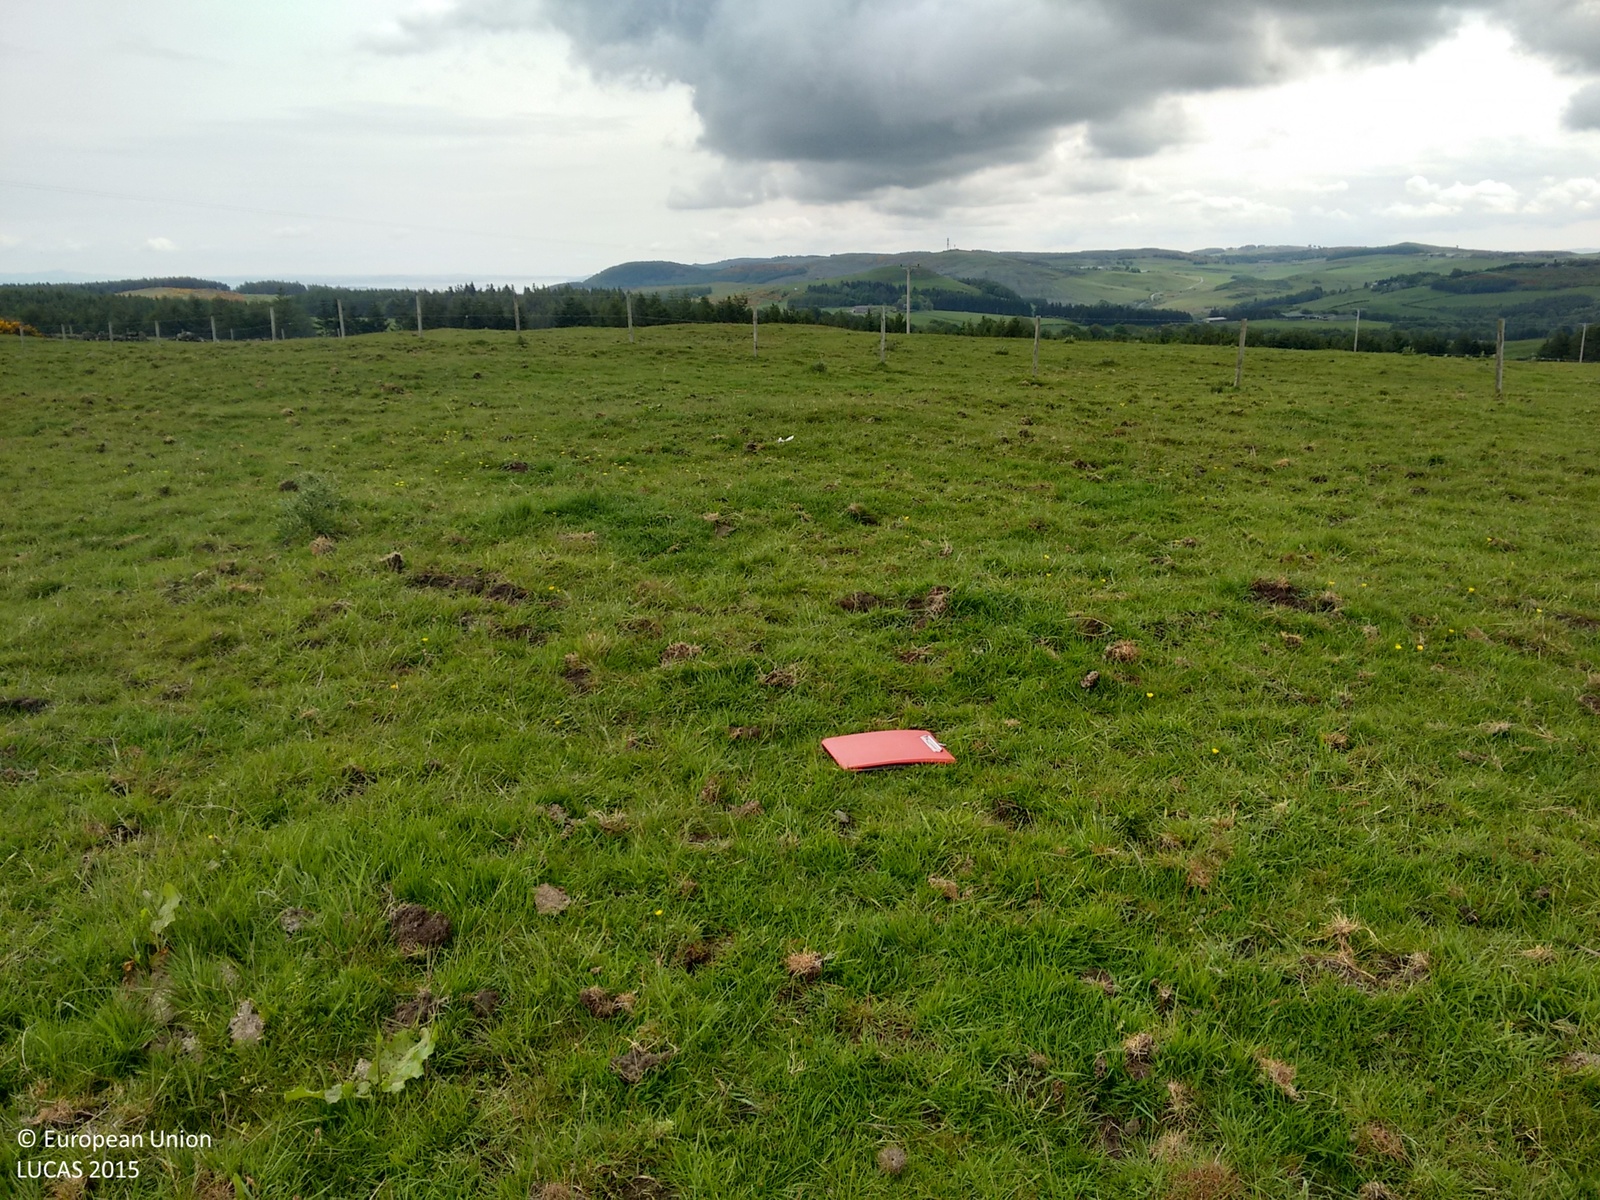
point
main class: Grassland
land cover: Grassland without tree/shrub cover
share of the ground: > 75 %
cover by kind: herbaceous plants 100 %
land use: Agriculture (excluding fallow land and kitchen gardens)
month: June
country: GB
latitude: 56.3015
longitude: -3.4069
